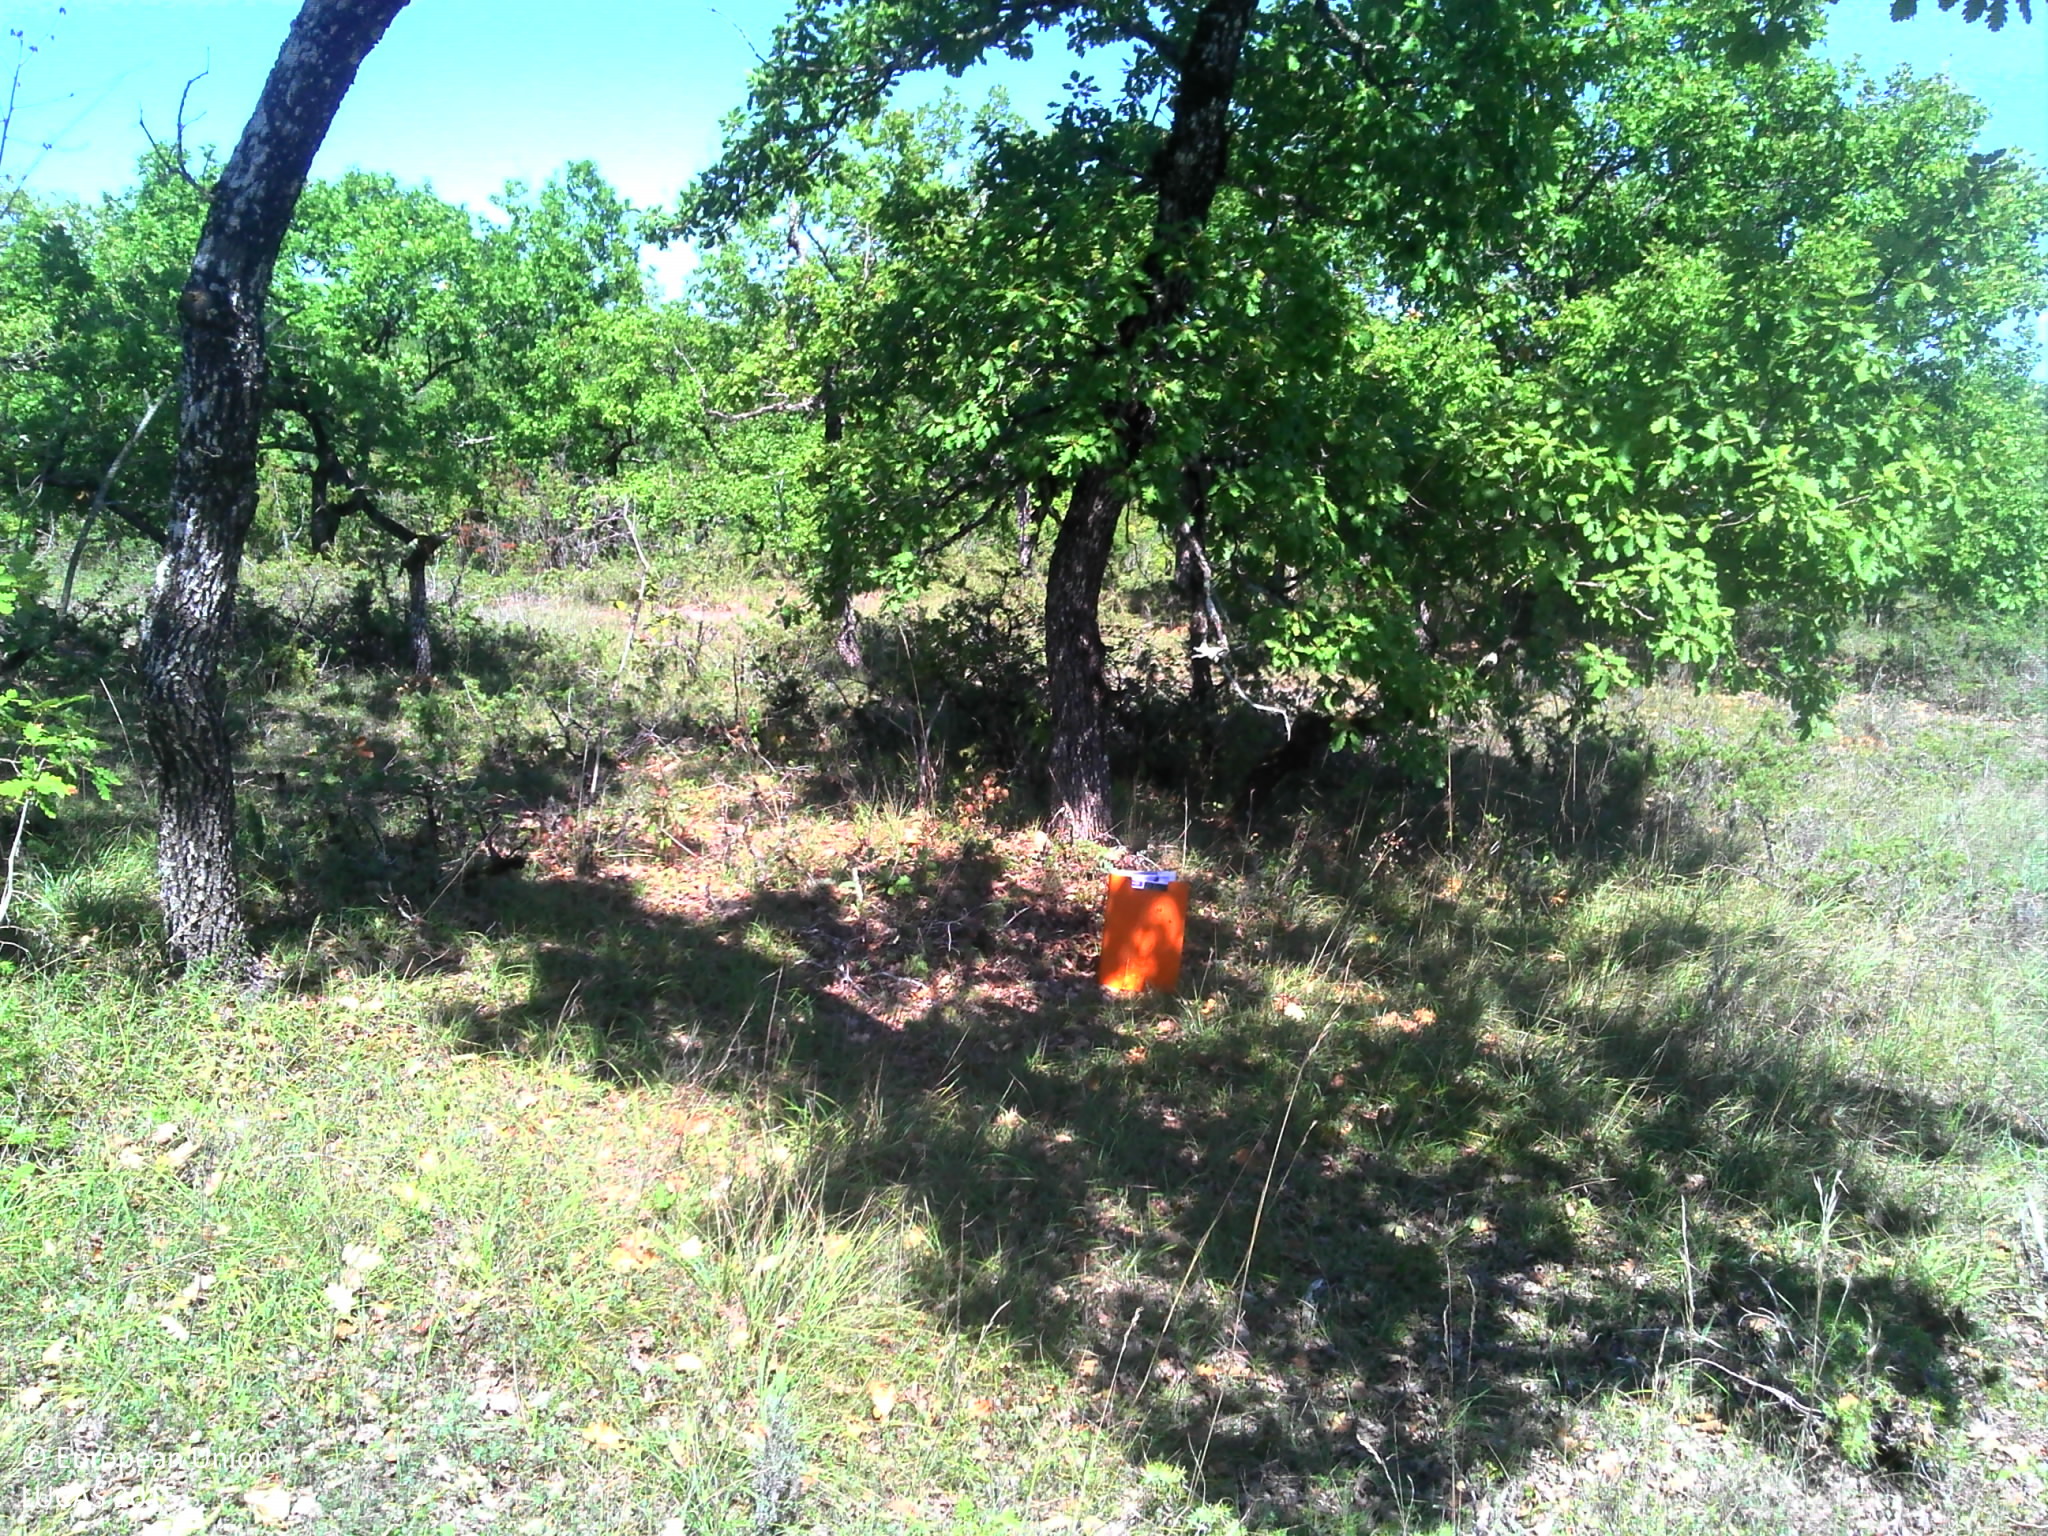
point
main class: Woodland
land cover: Broadleaved woodland
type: thermophilous deciduous forest
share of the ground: > 75 %
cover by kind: broadleaved forest trees 50 %, herbaceous plants 35 %, shrubs 10 %, lichens and mosses 5 %
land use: Forestry
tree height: > 5 m
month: August
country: FR
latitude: 44.3263
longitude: 1.4845
